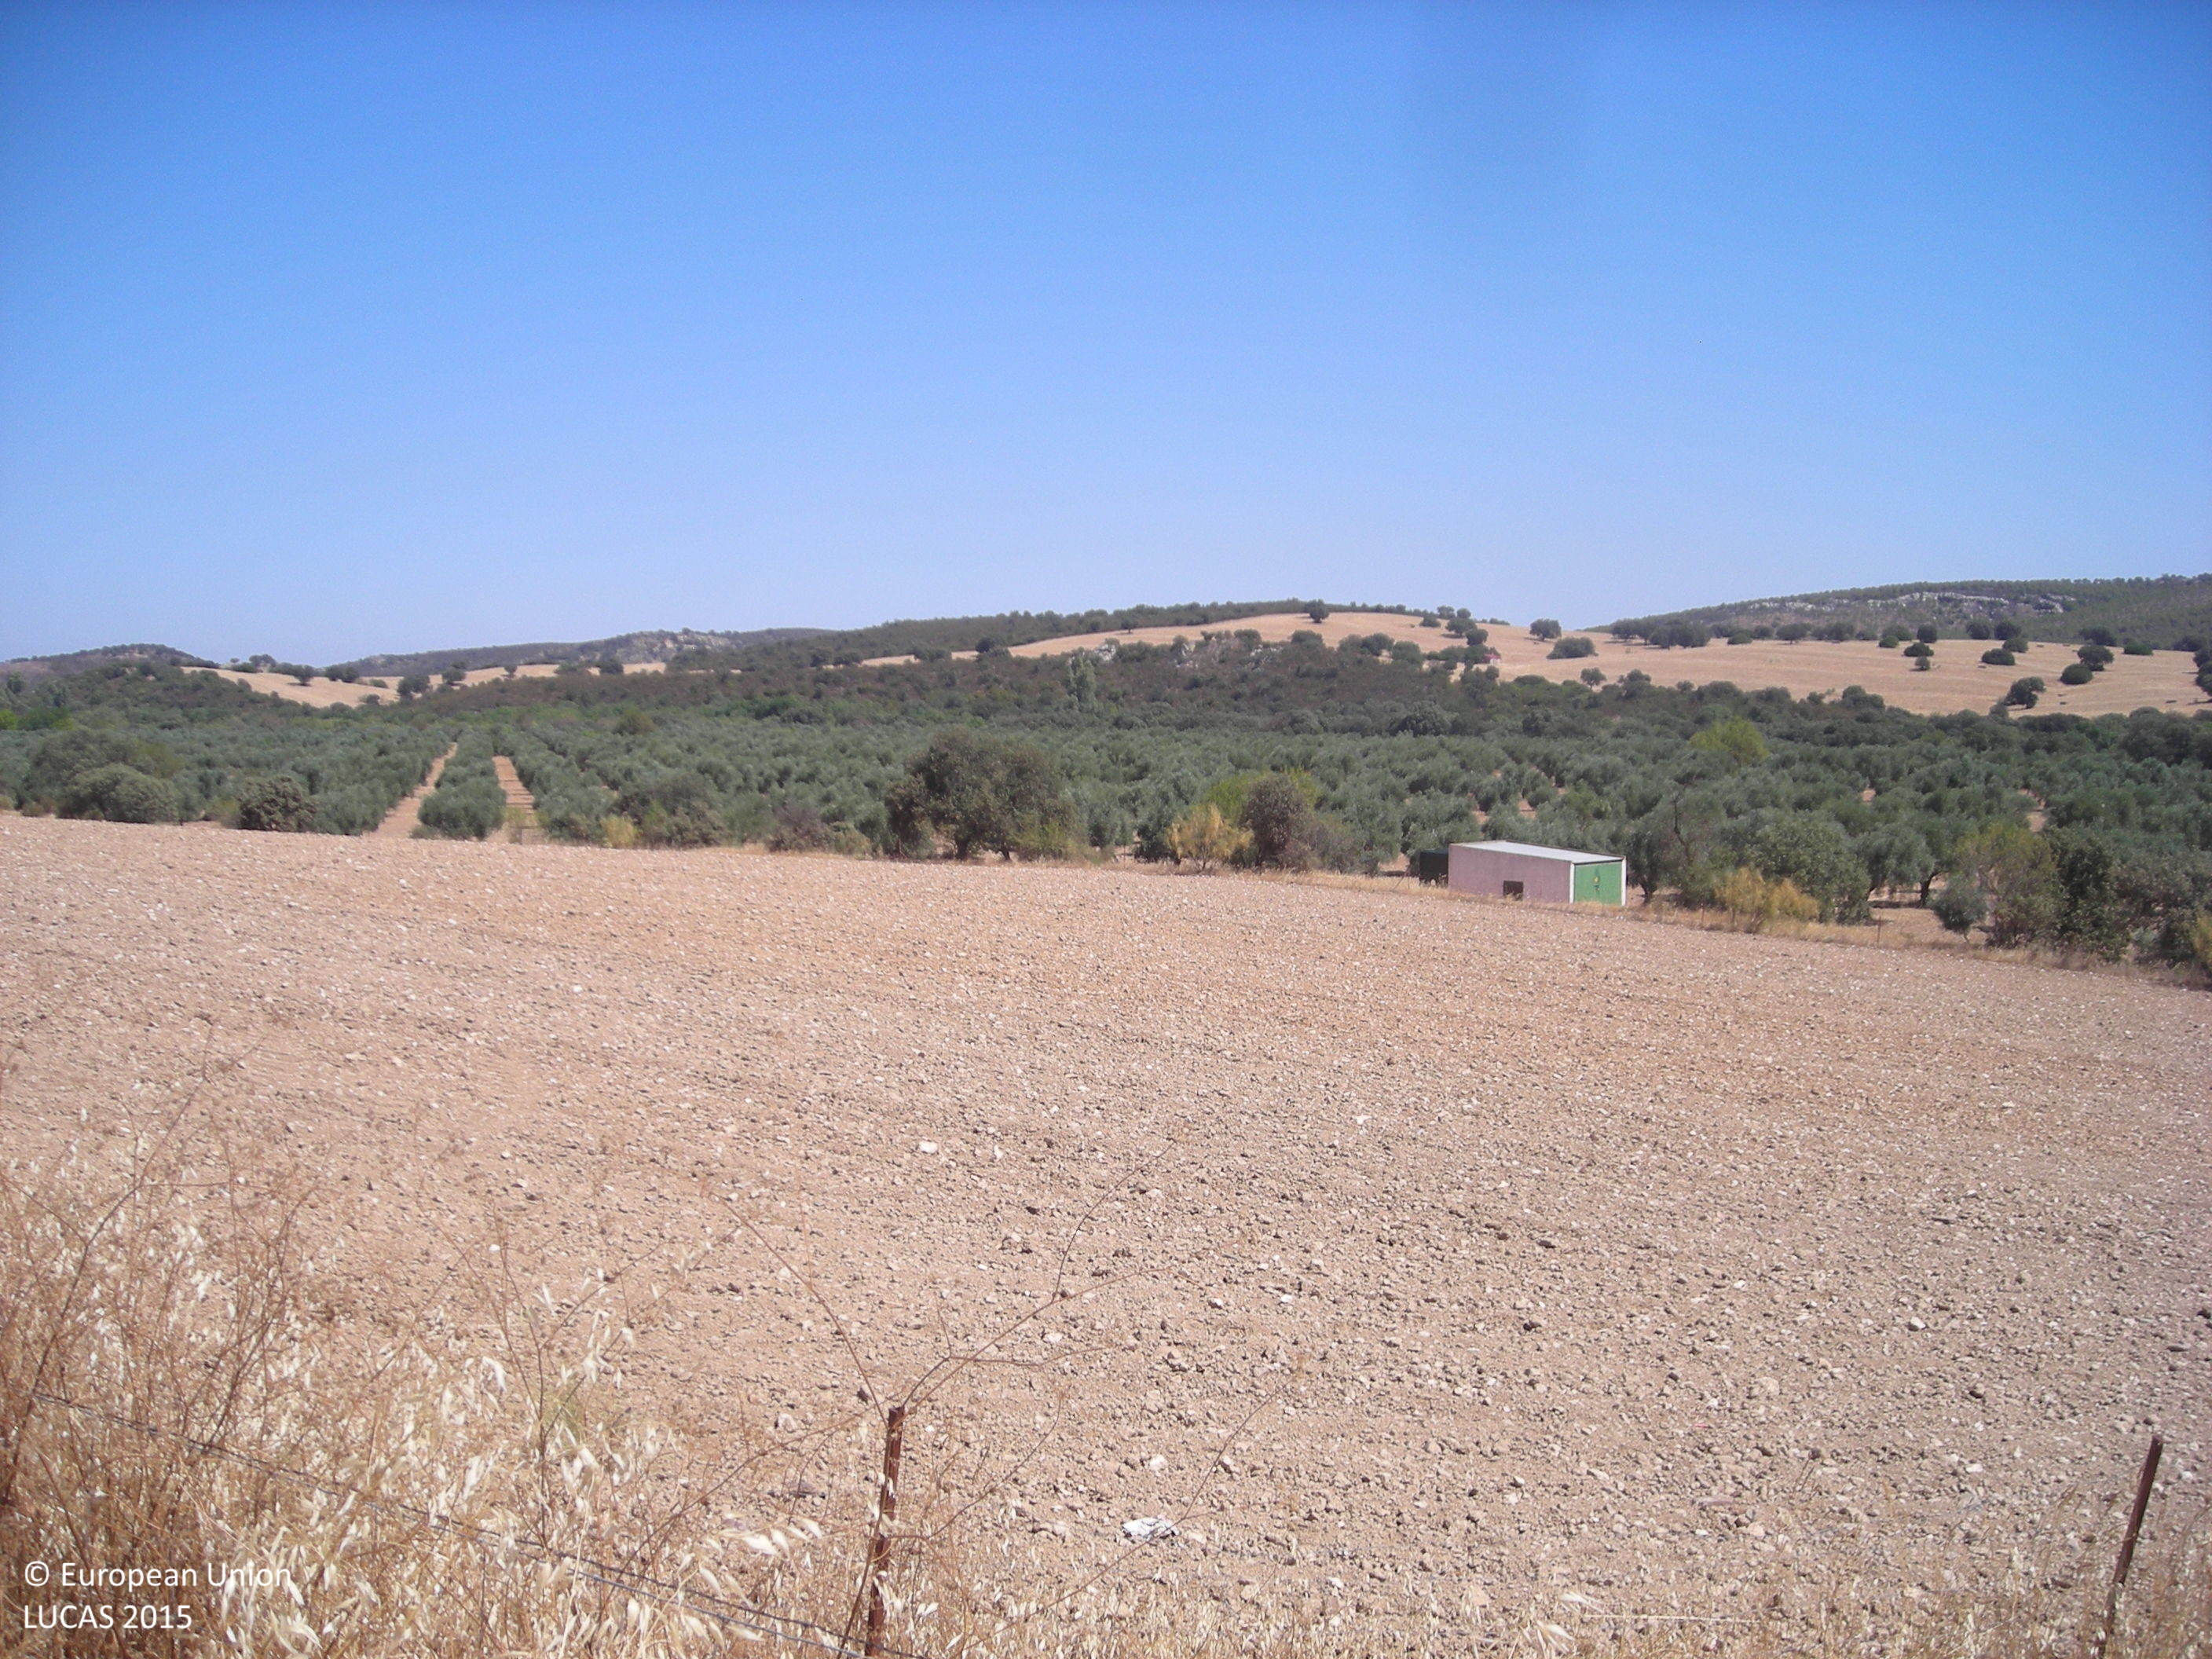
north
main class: Cropland
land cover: Temporary grasslands
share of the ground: > 75 %
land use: Agriculture (excluding fallow land and kitchen gardens)
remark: Harvested field
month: July
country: ES
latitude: 38.8094
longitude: -5.9284
